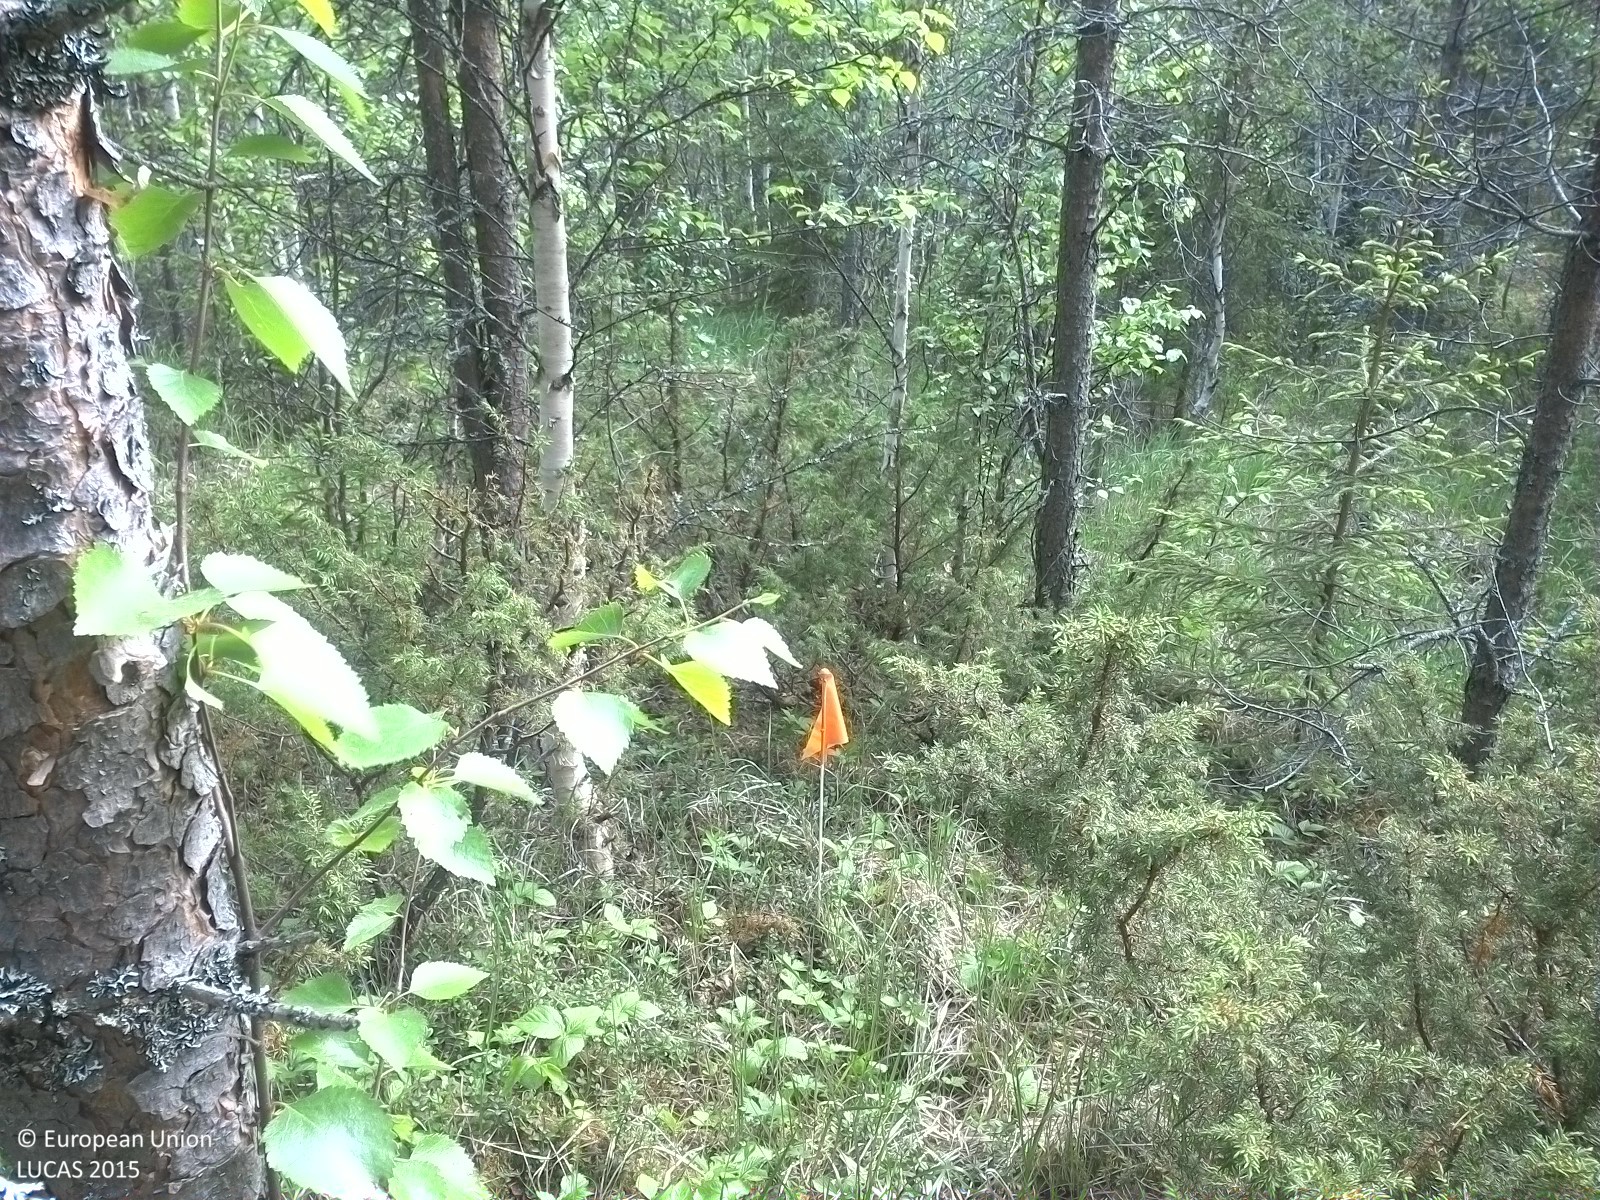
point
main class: Woodland
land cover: Other mixed woodland
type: boreal forest
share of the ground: > 75 %
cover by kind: coniferous forest trees 60 %, broadleaved forest trees 20 %, herbaceous plants 20 %
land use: Forestry
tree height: > 5 m
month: June
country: SE
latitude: 63.6199
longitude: 15.3609
